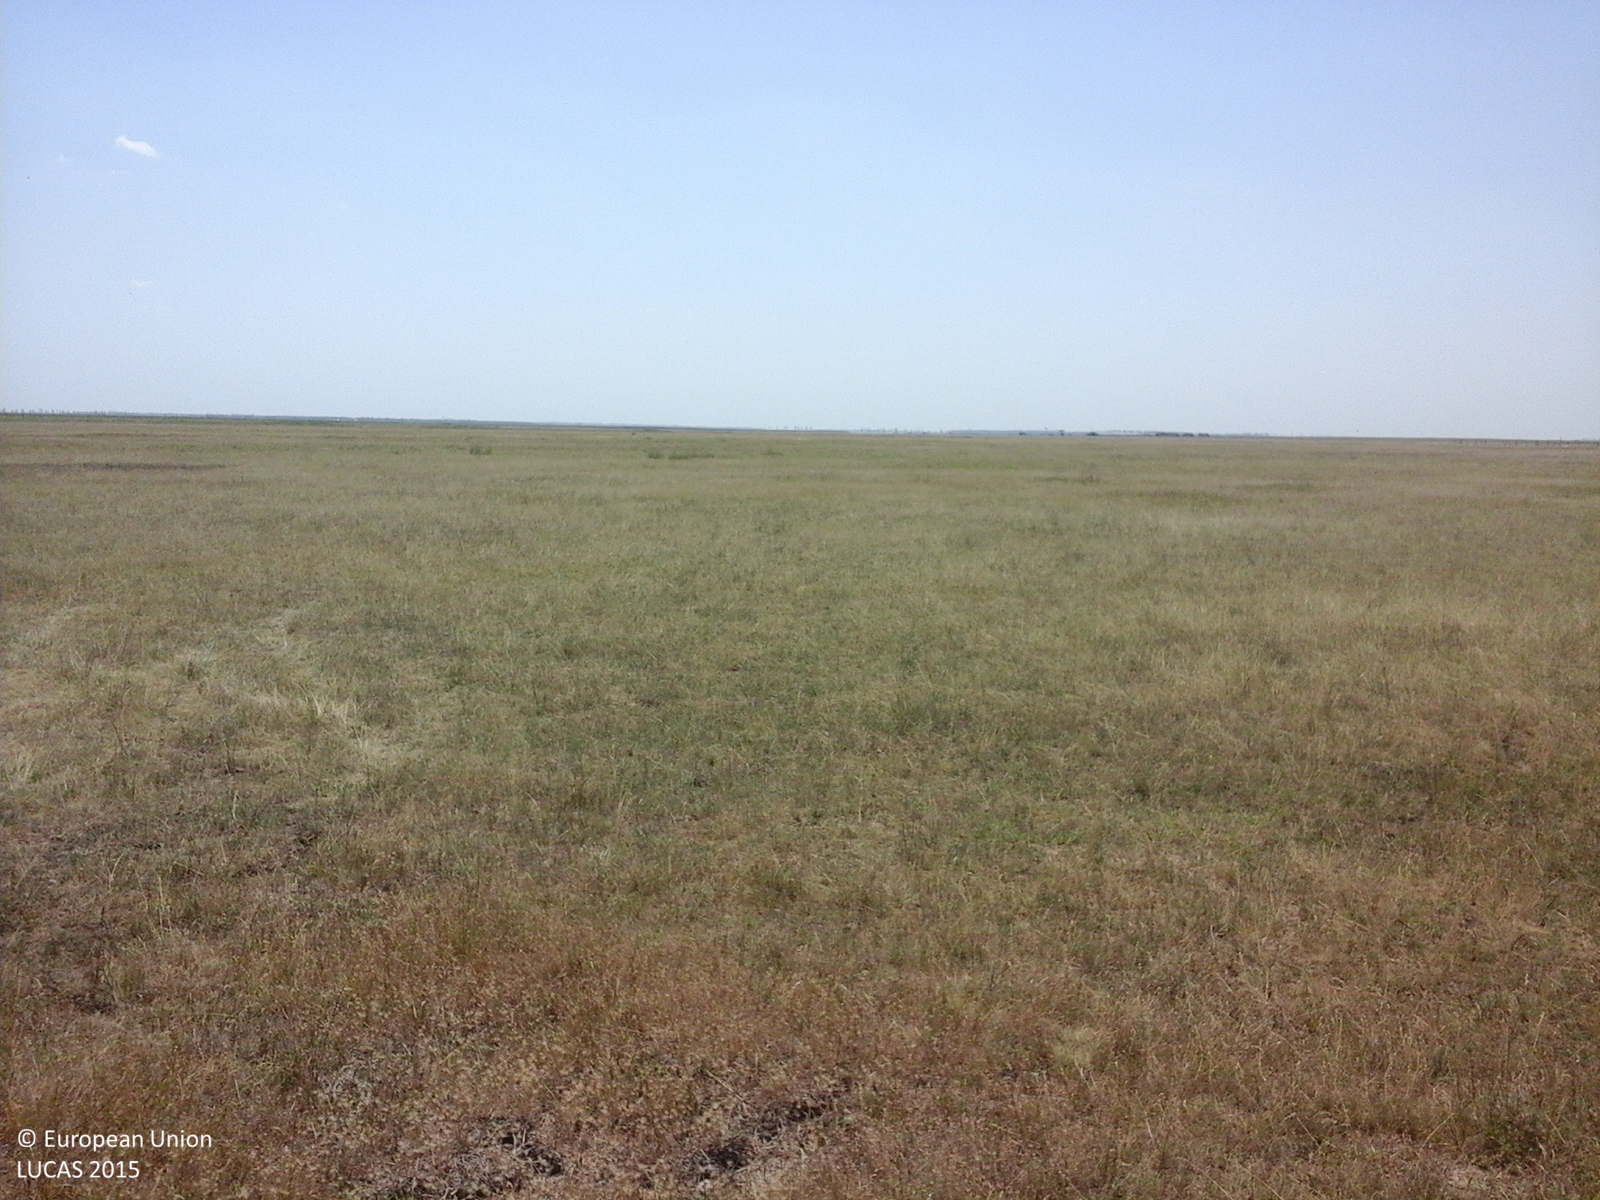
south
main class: Grassland
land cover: Grassland without tree/shrub cover
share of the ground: > 75 %
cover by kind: herbaceous plants 100 %
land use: Agriculture (excluding fallow land and kitchen gardens)
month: July
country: RO
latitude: 45.0496
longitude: 26.6697
